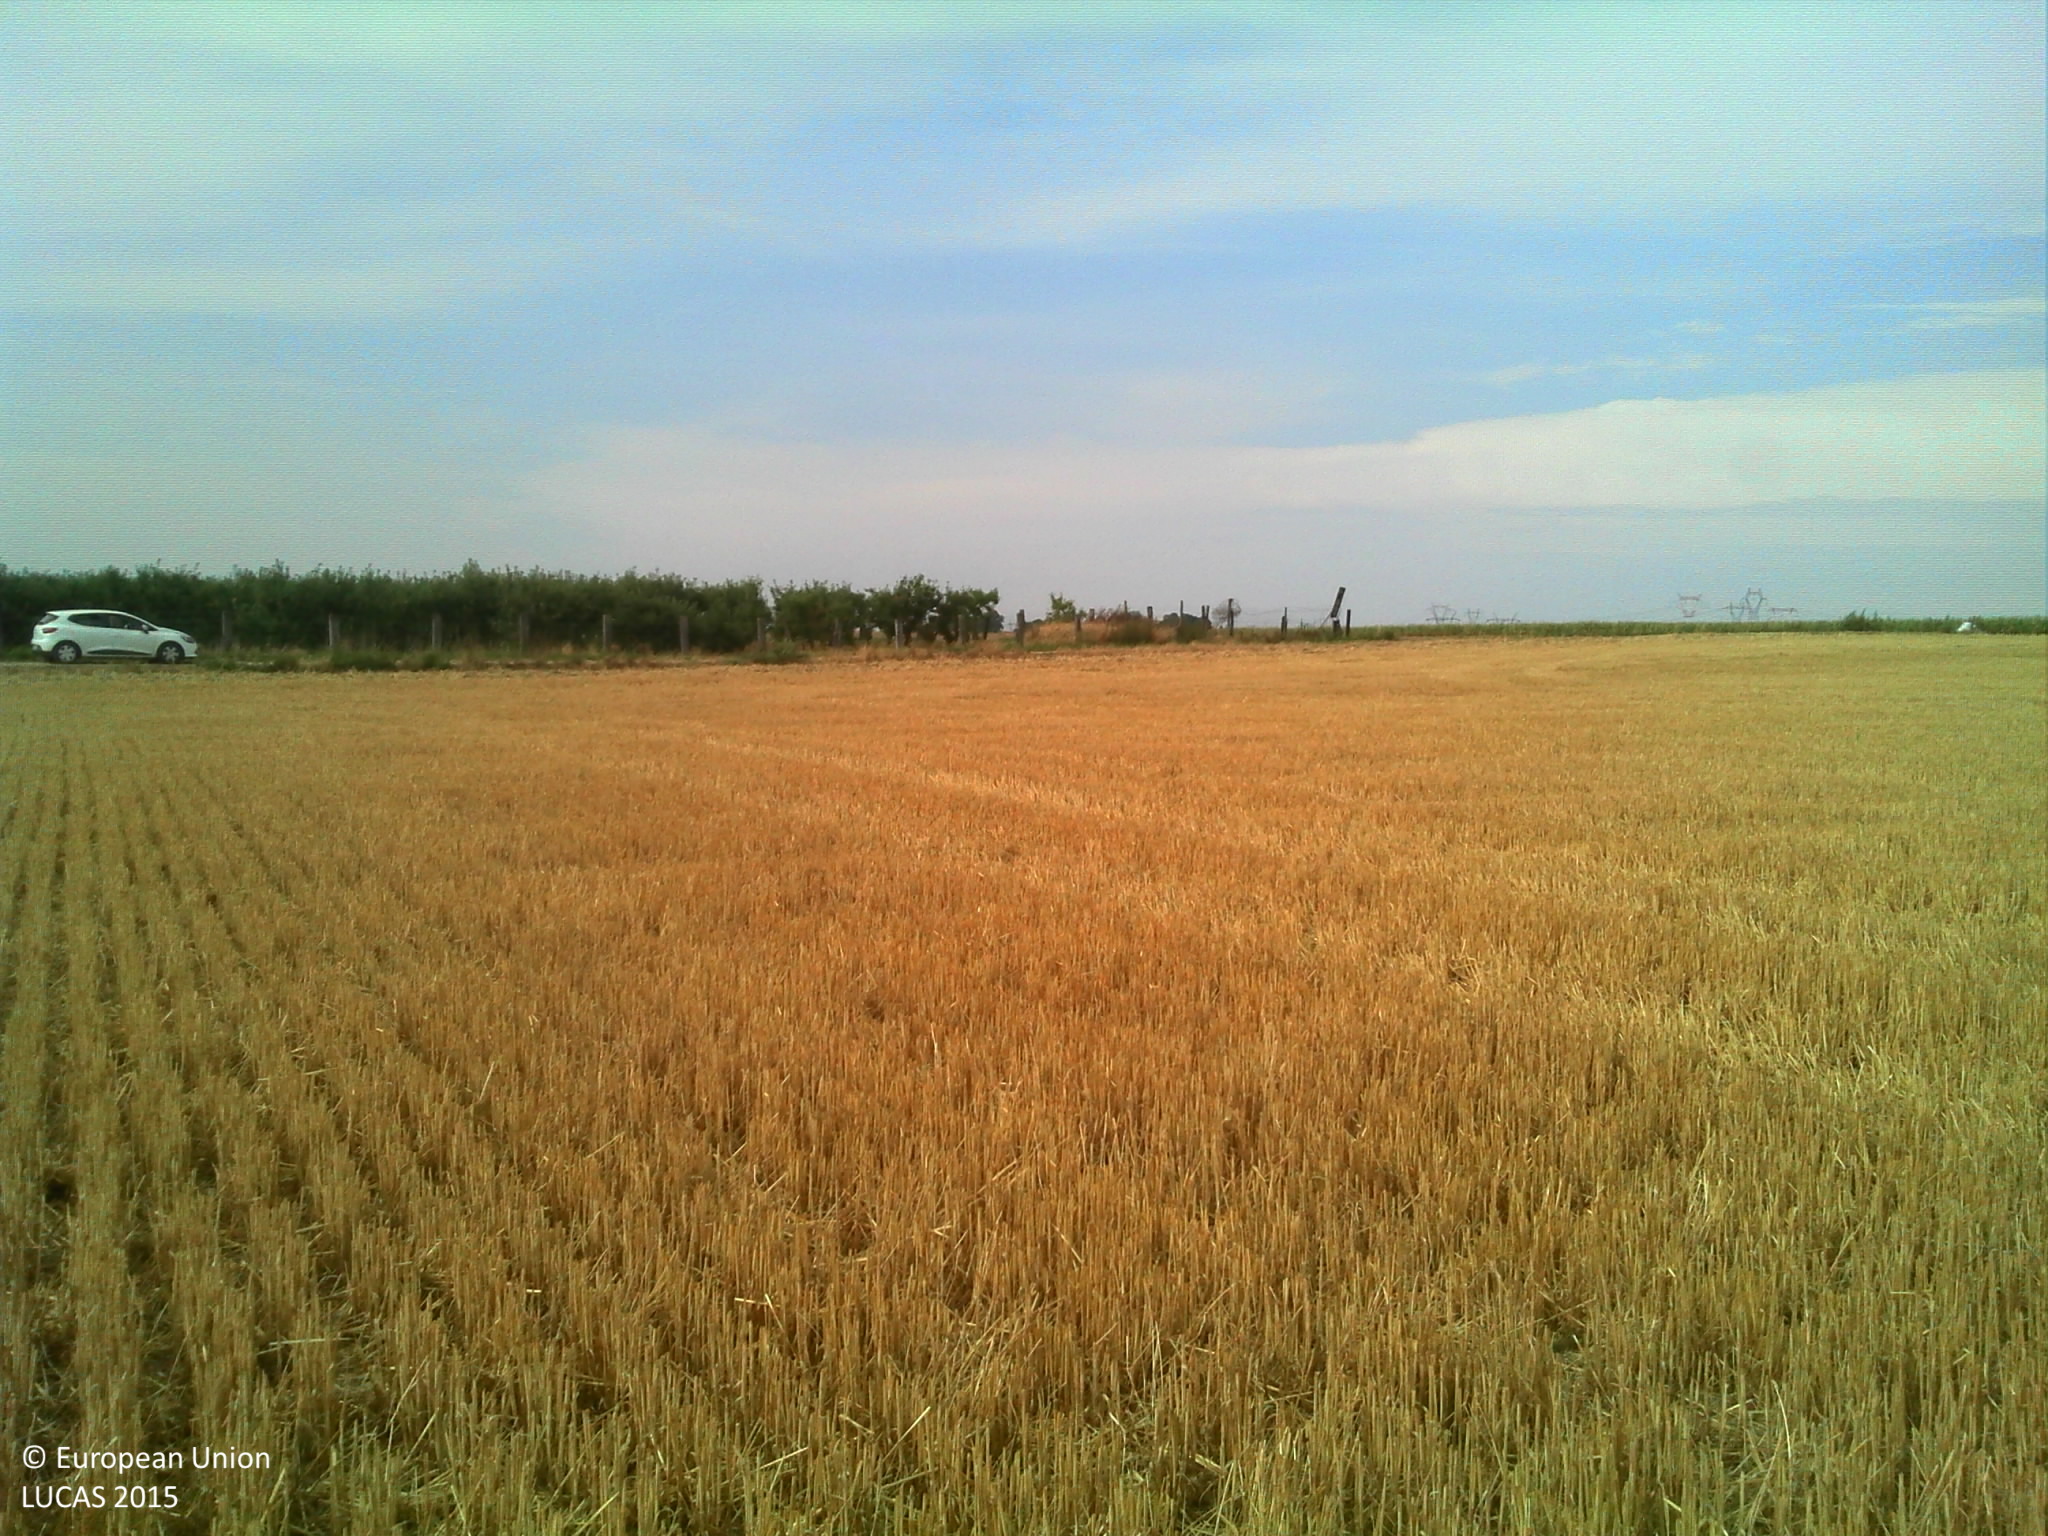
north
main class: Cropland
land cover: Common wheat
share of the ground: > 75 %
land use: Agriculture (excluding fallow land and kitchen gardens)
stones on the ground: < 10 %
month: August
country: FR
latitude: 49.0110
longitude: 2.4276
